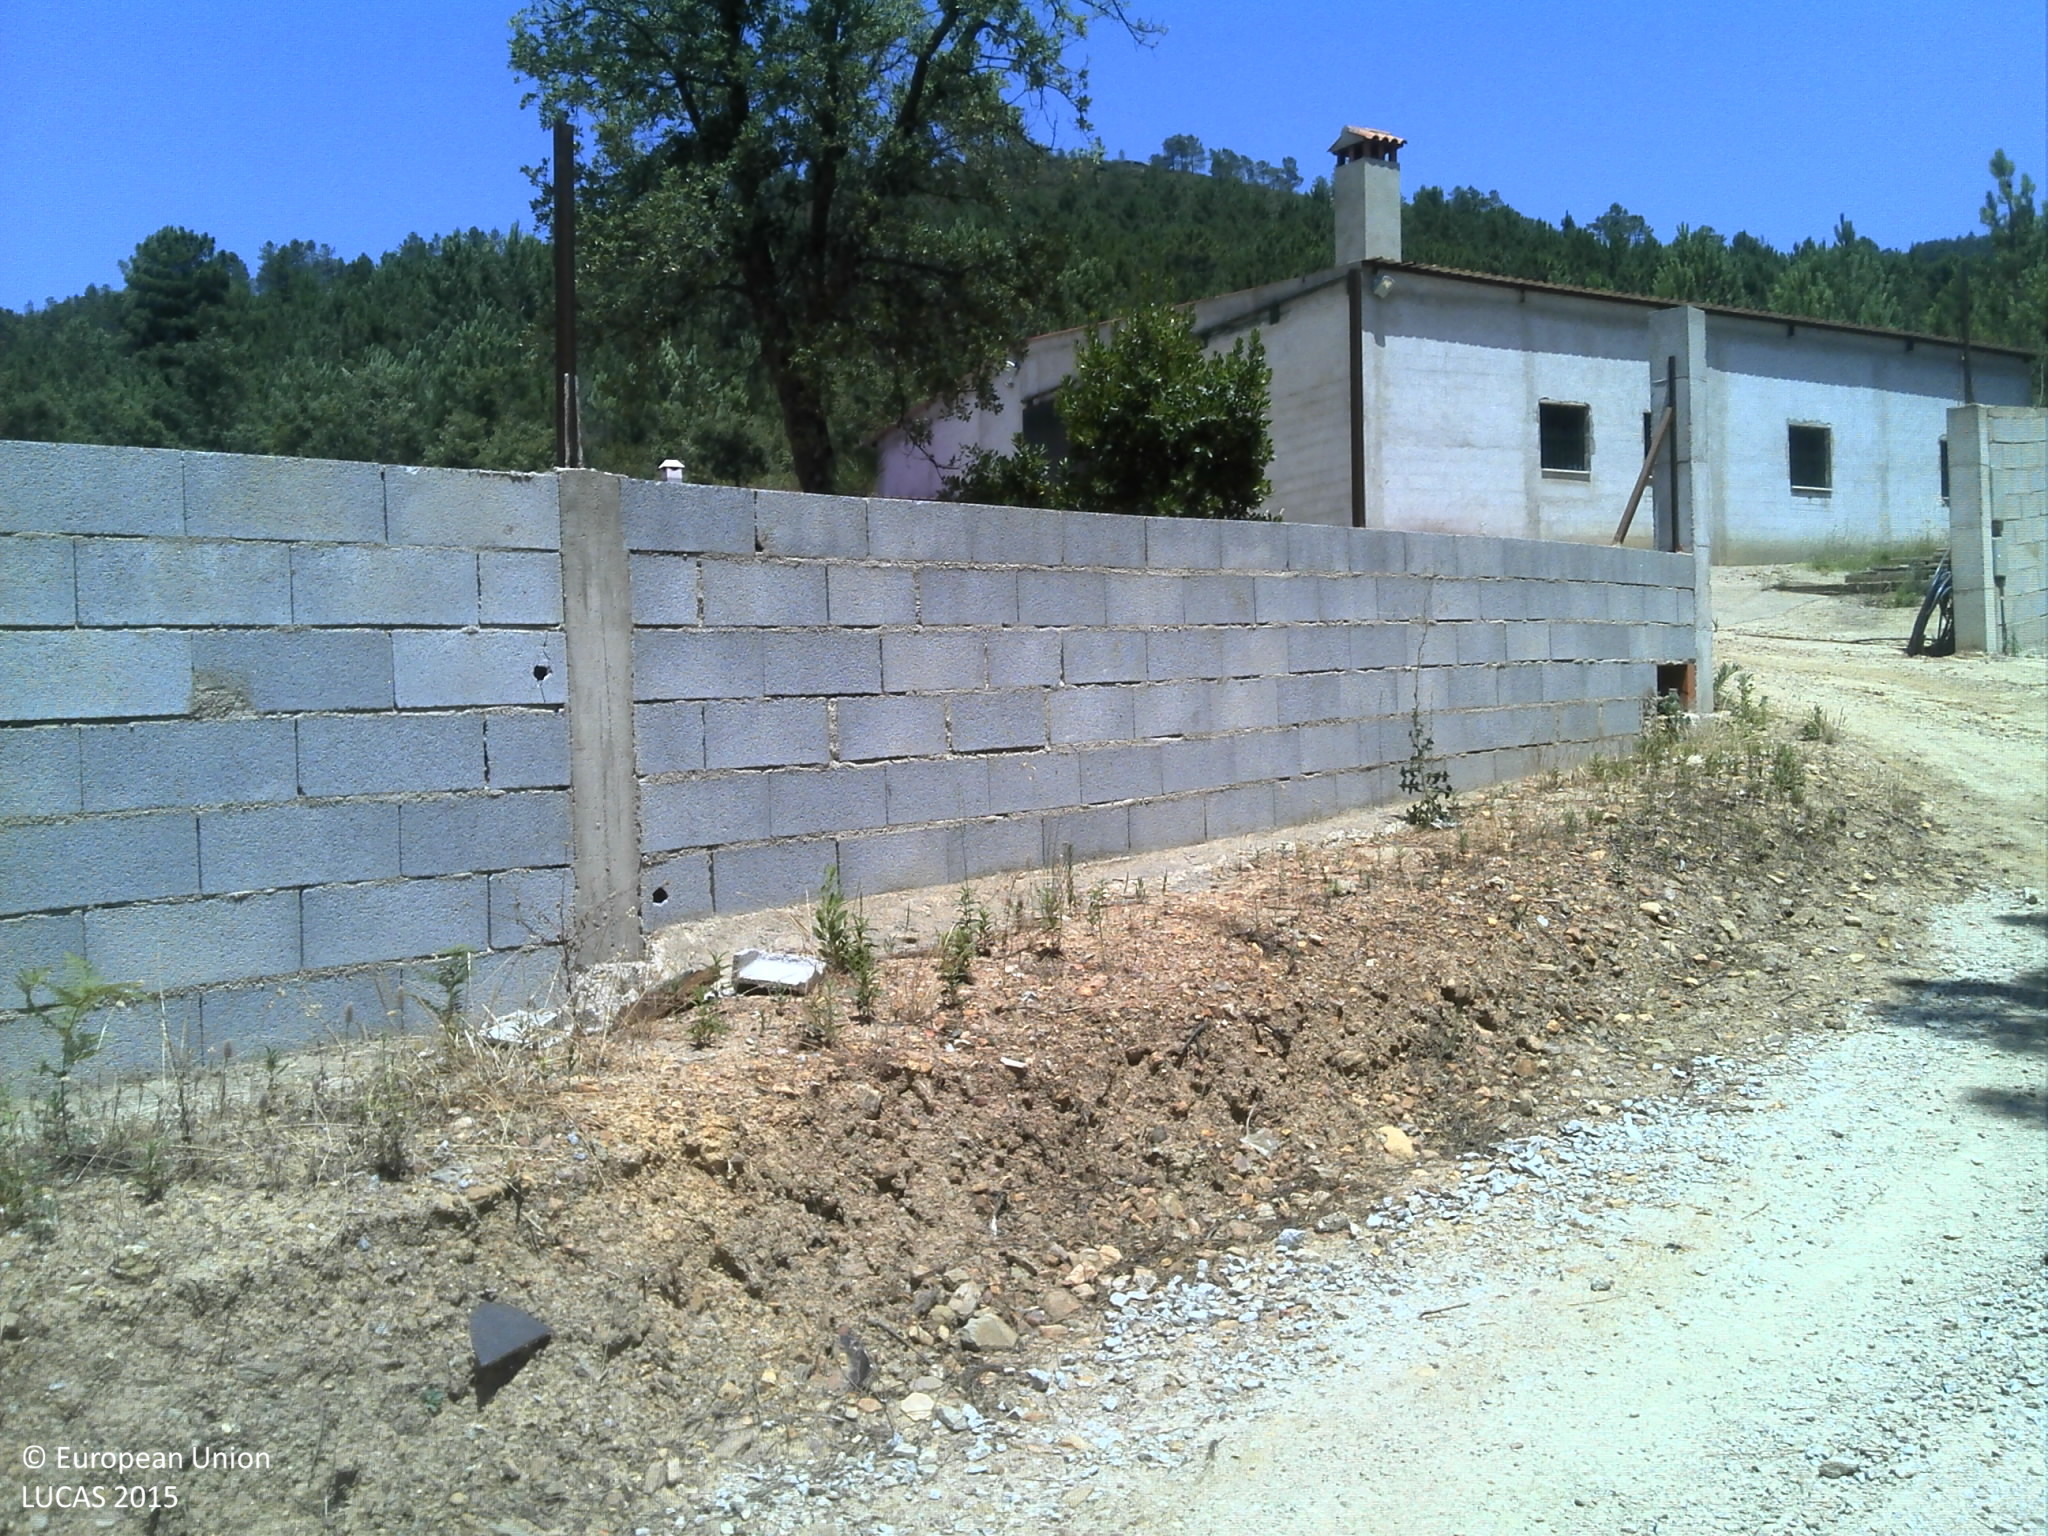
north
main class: Woodland
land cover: Pine dominated coniferous woodland
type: coniferous forest of the mediterranean region
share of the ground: 50 - 75 %
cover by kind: coniferous forest trees 70 %, shrubs 10 %, unconsolidated bare surface 10 %, herbaceous plants 5 %
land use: Forestry
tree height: > 5 m
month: June
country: PT
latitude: 40.0836
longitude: -7.0872
